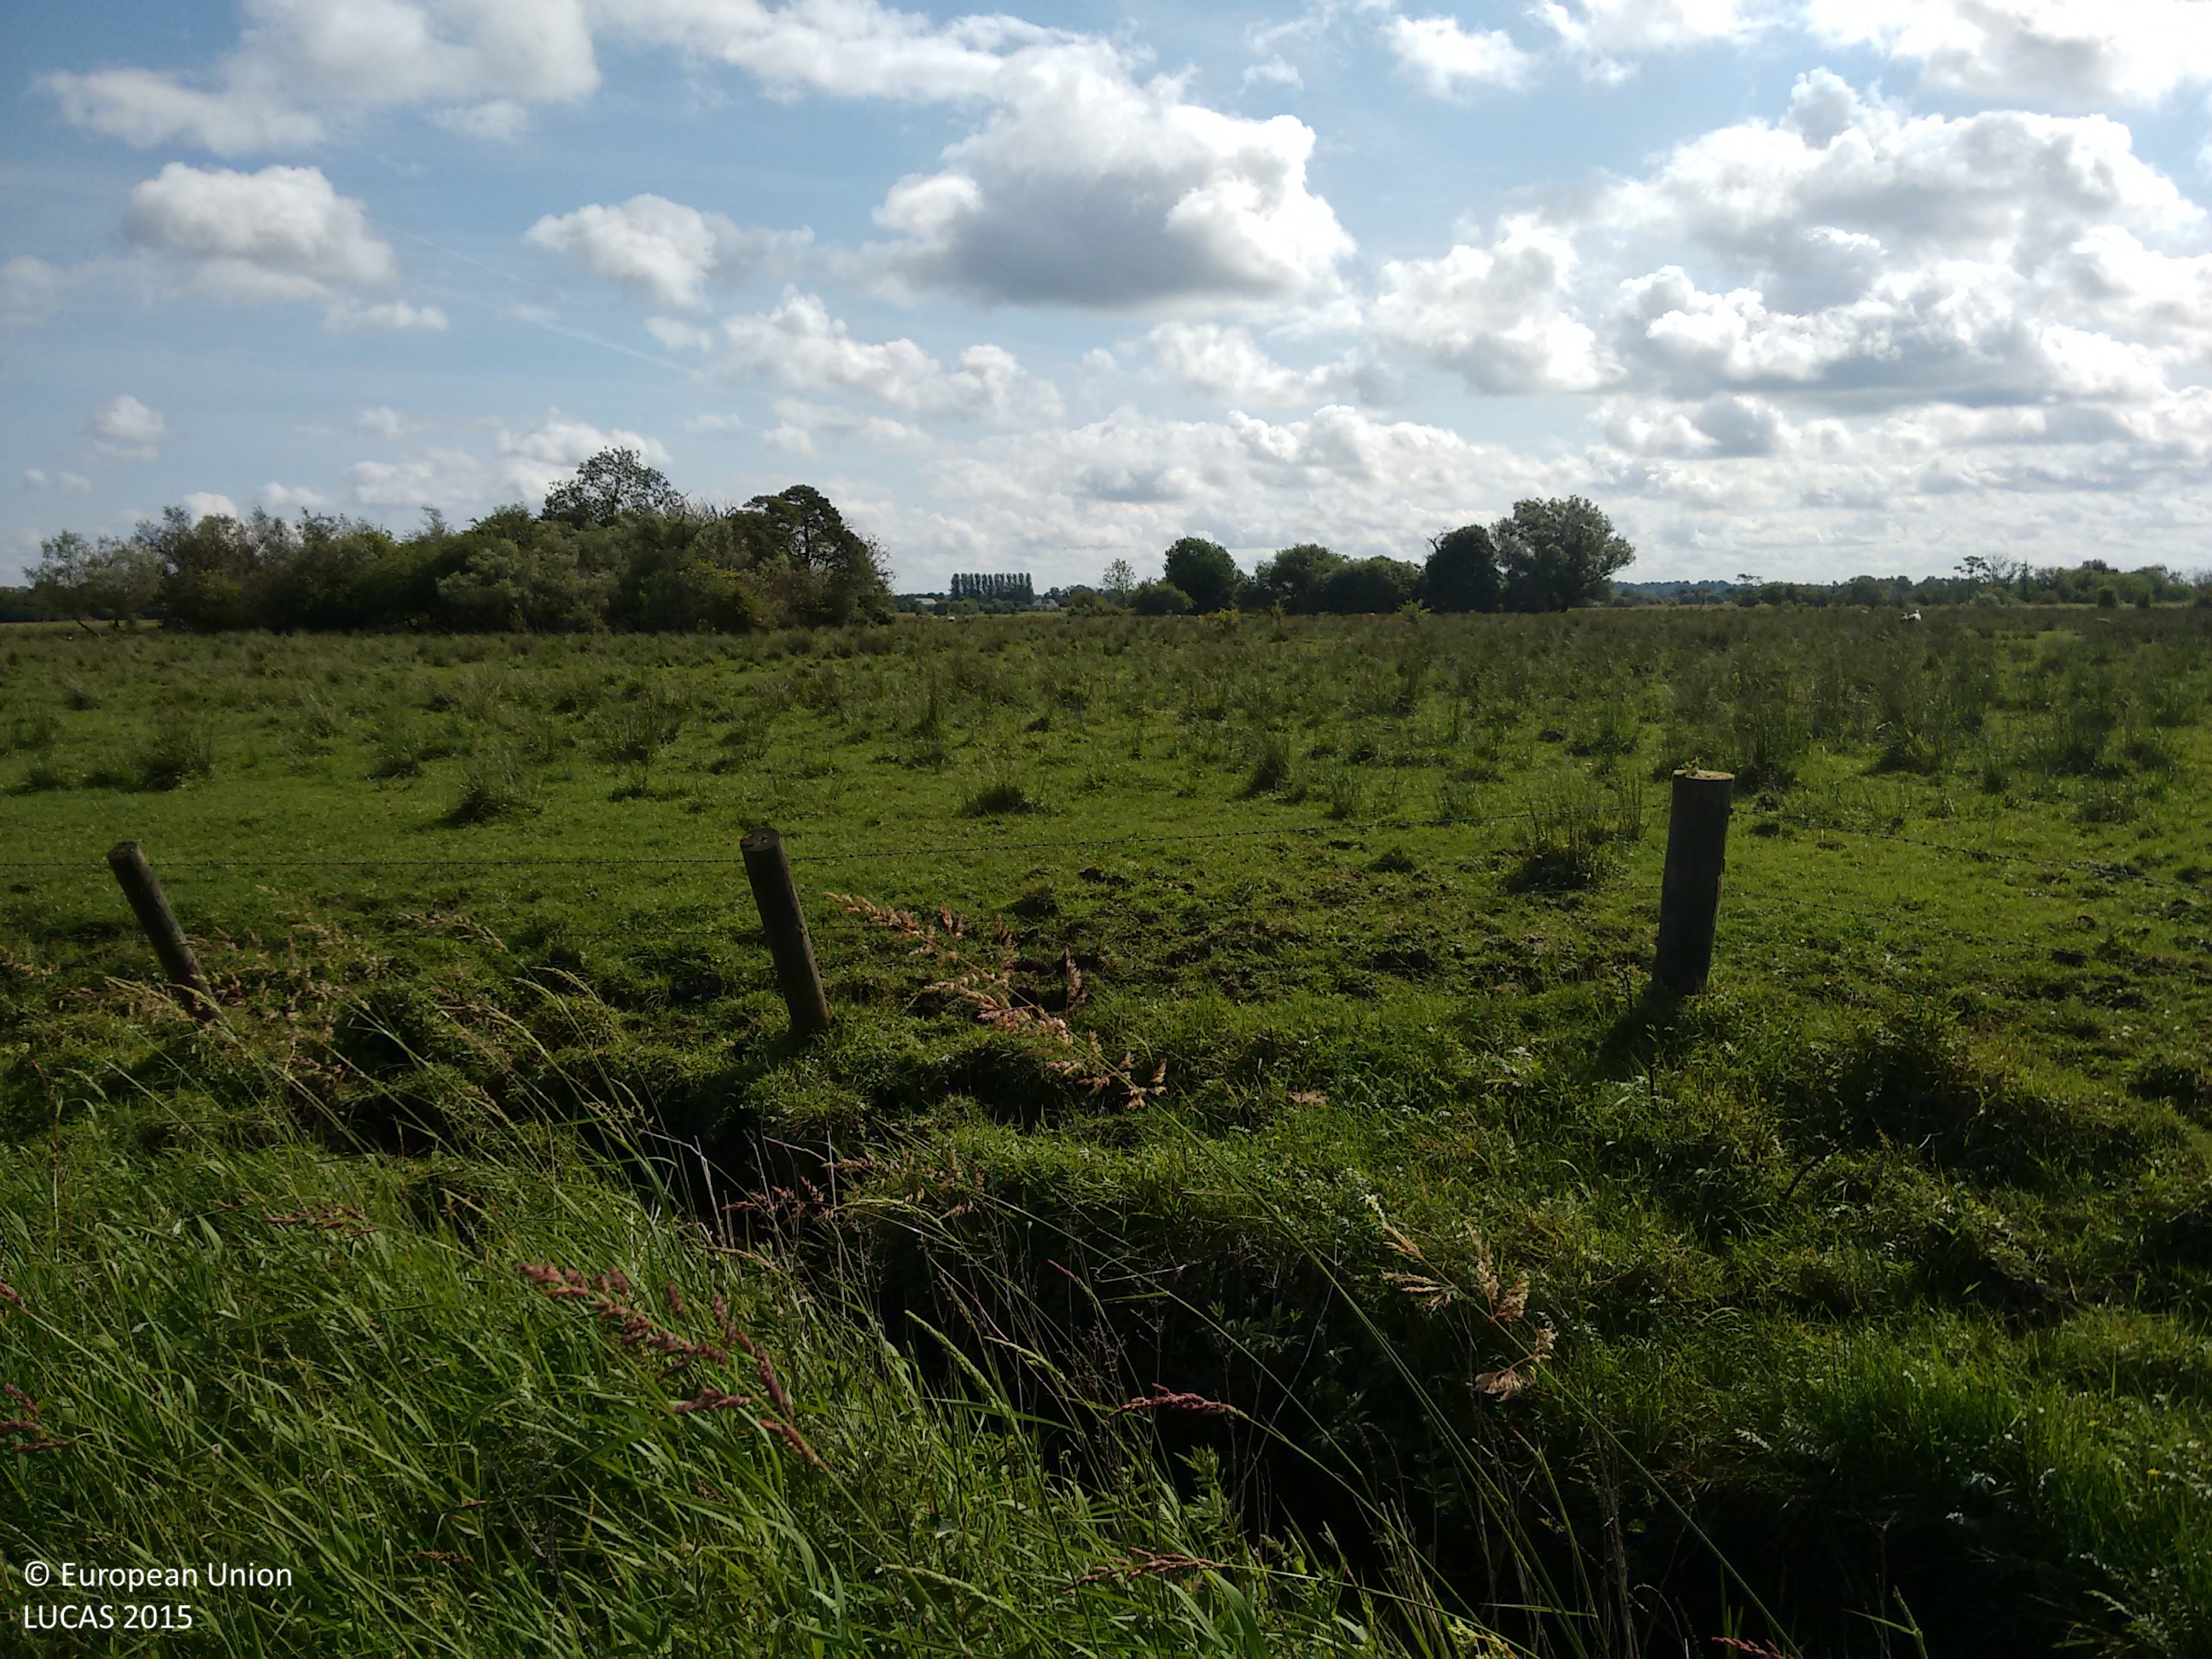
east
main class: Grassland
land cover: Grassland without tree/shrub cover
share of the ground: > 75 %
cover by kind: herbaceous plants 100 %
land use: Agriculture (excluding fallow land and kitchen gardens)
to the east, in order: Grassland without tree/shrub cover; Fences; Grassland without tree/shrub cover
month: July
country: IE
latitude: 53.3937
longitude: -7.9326
